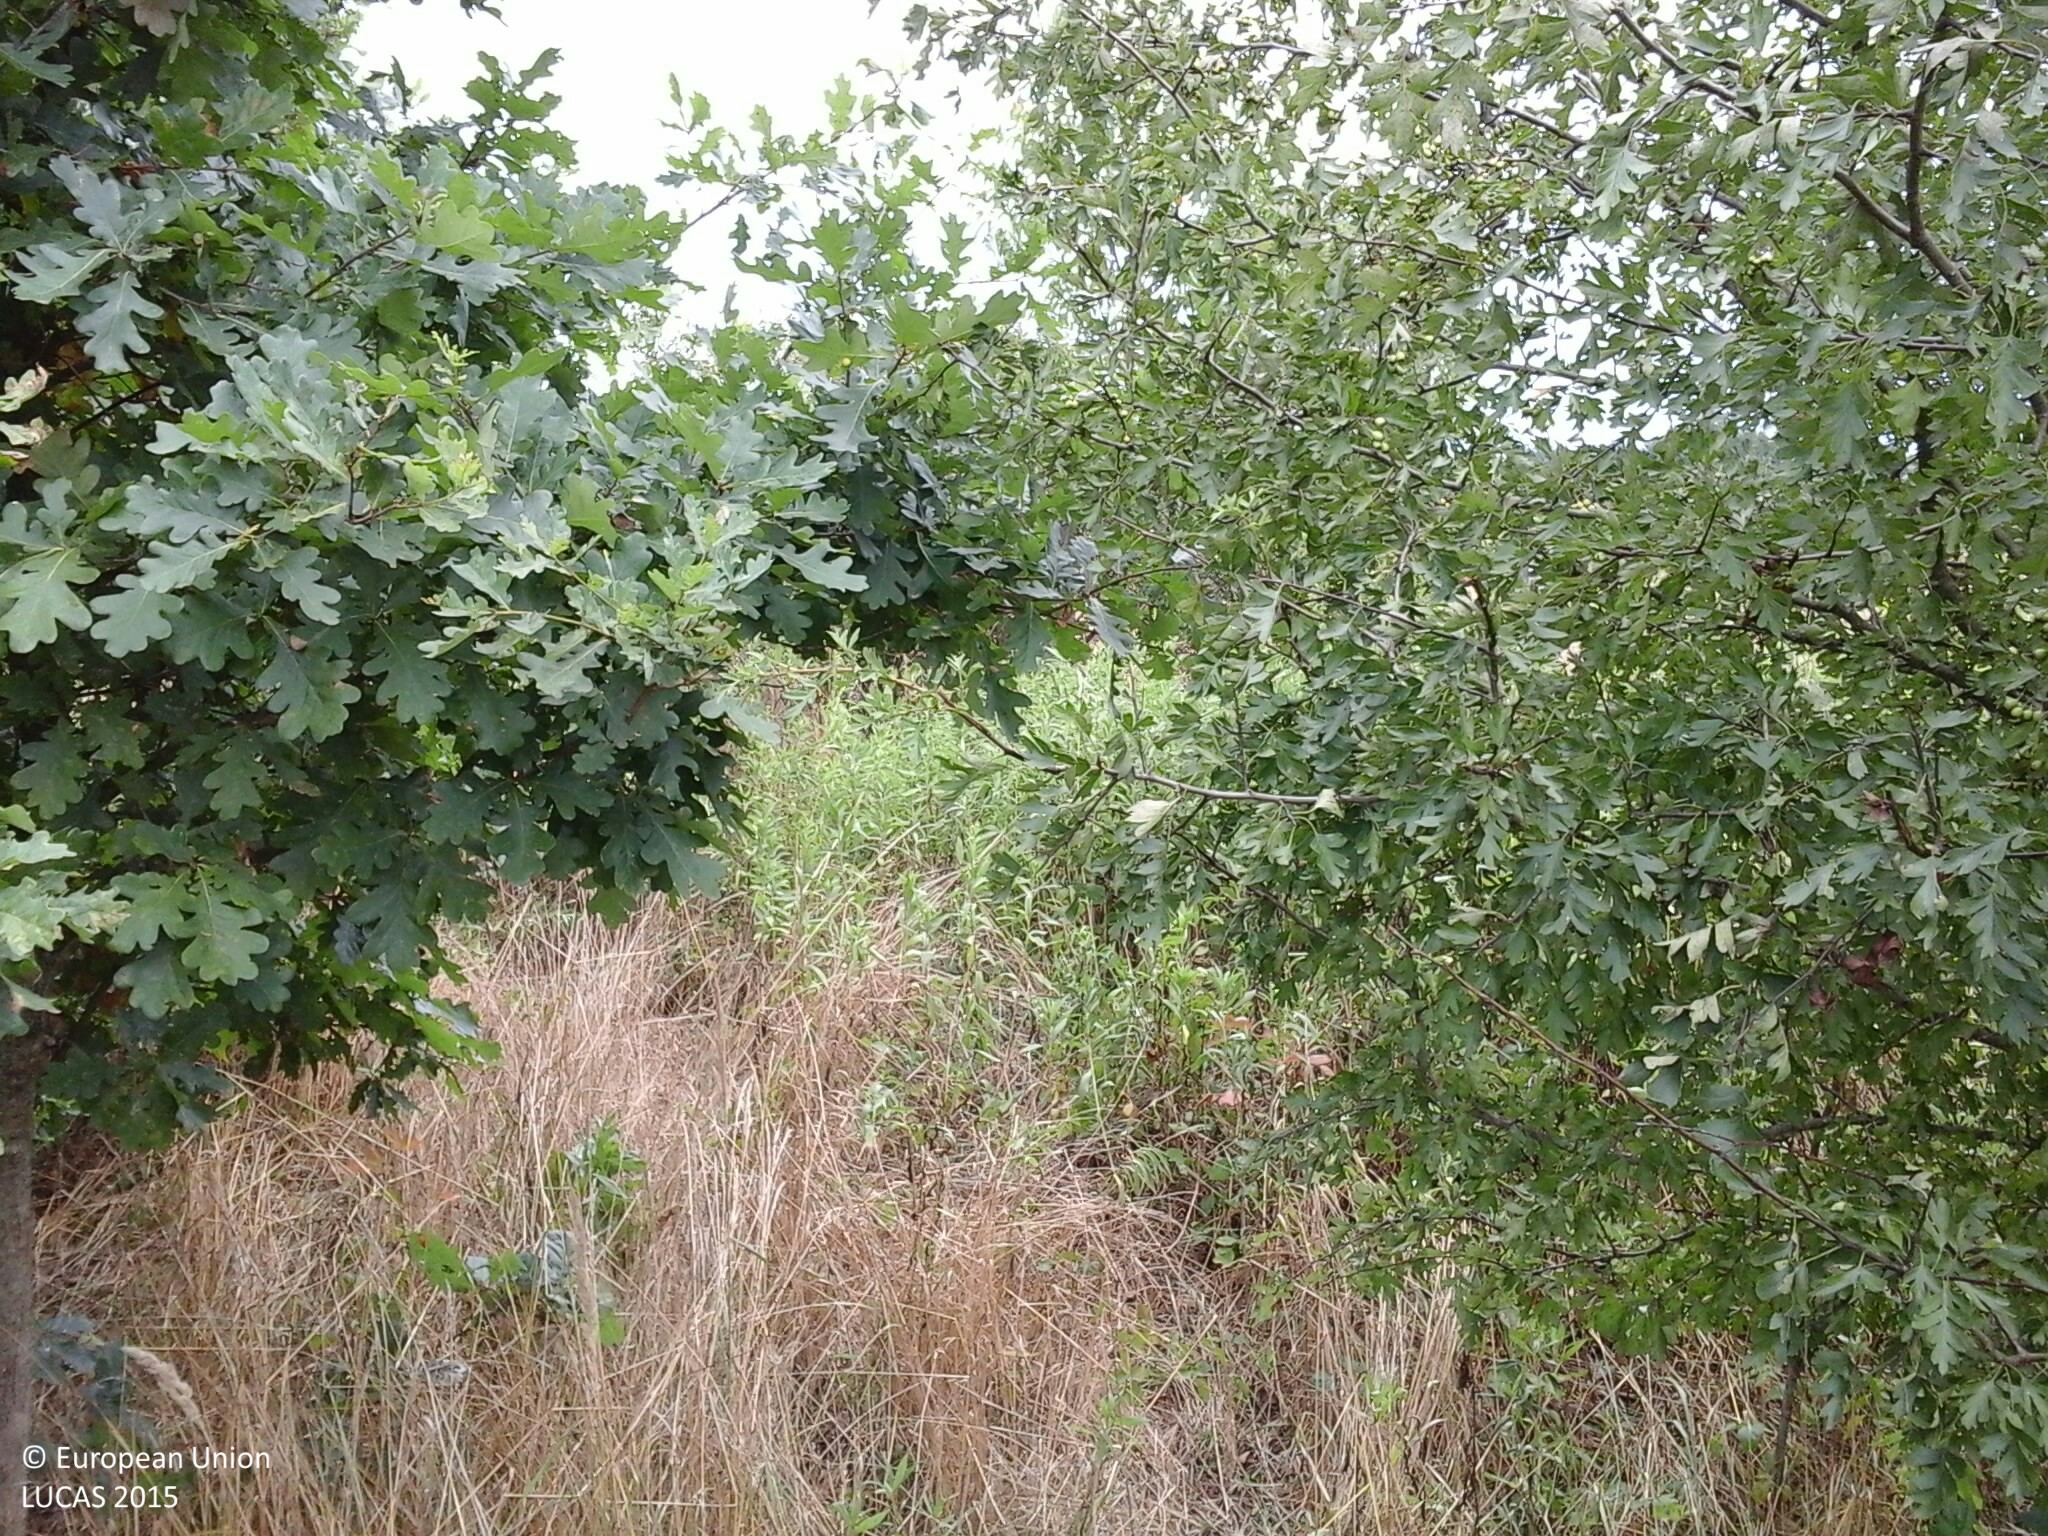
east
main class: Shrubland
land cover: Shrubland with sparse tree cover
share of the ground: > 75 %
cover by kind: shrubs 65 %, herbaceous plants 30 %, broadleaved forest trees 5 %
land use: Semi-natural and natural areas not in use
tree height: < 5 m
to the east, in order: Shrubland with sparse tree cover; Fences; Grass margins; Common wheat; Fences; Maize; Common wheat; Electric lines; Common wheat; Lines of trees; Fences; Grassland without tree/shrub cover
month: July
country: HU
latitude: 46.7117
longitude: 16.5293
